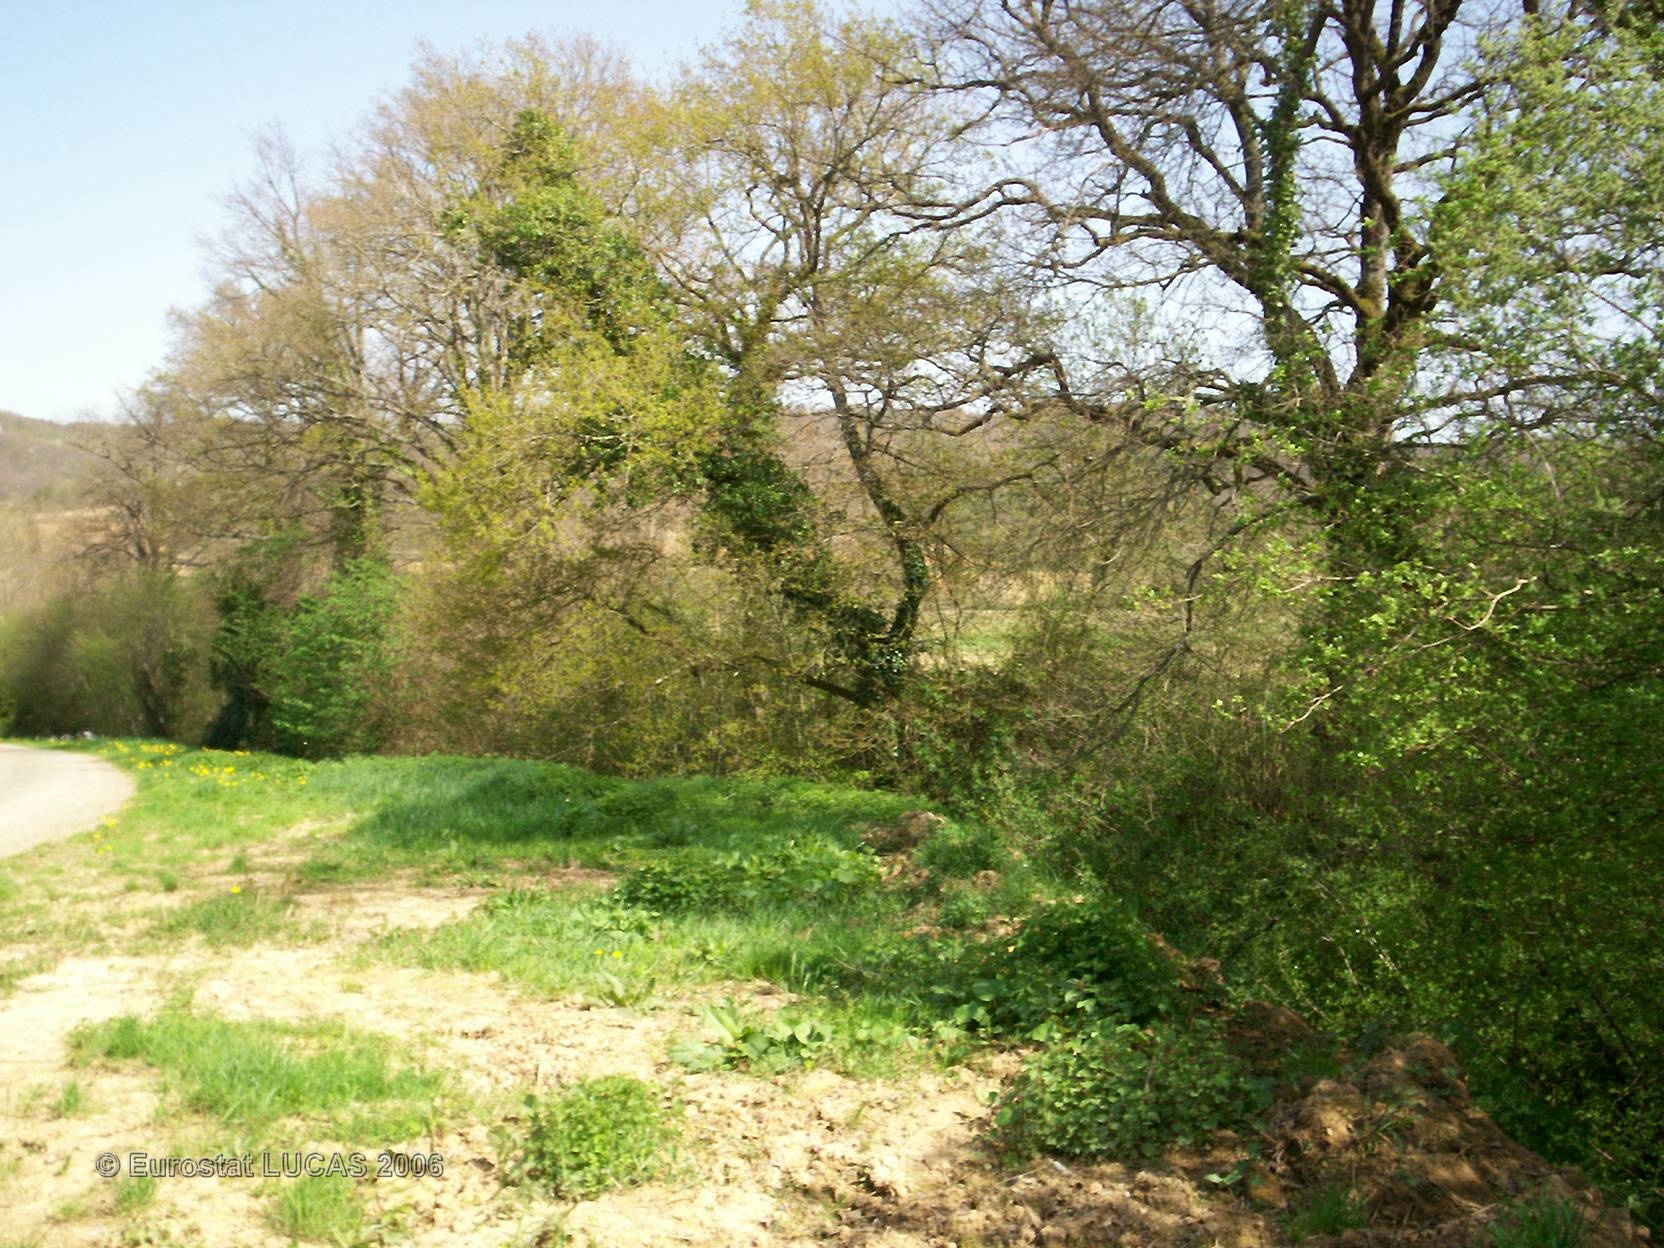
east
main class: Woodland
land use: Unused
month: April
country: FR
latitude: 43.3803
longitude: 0.2337
